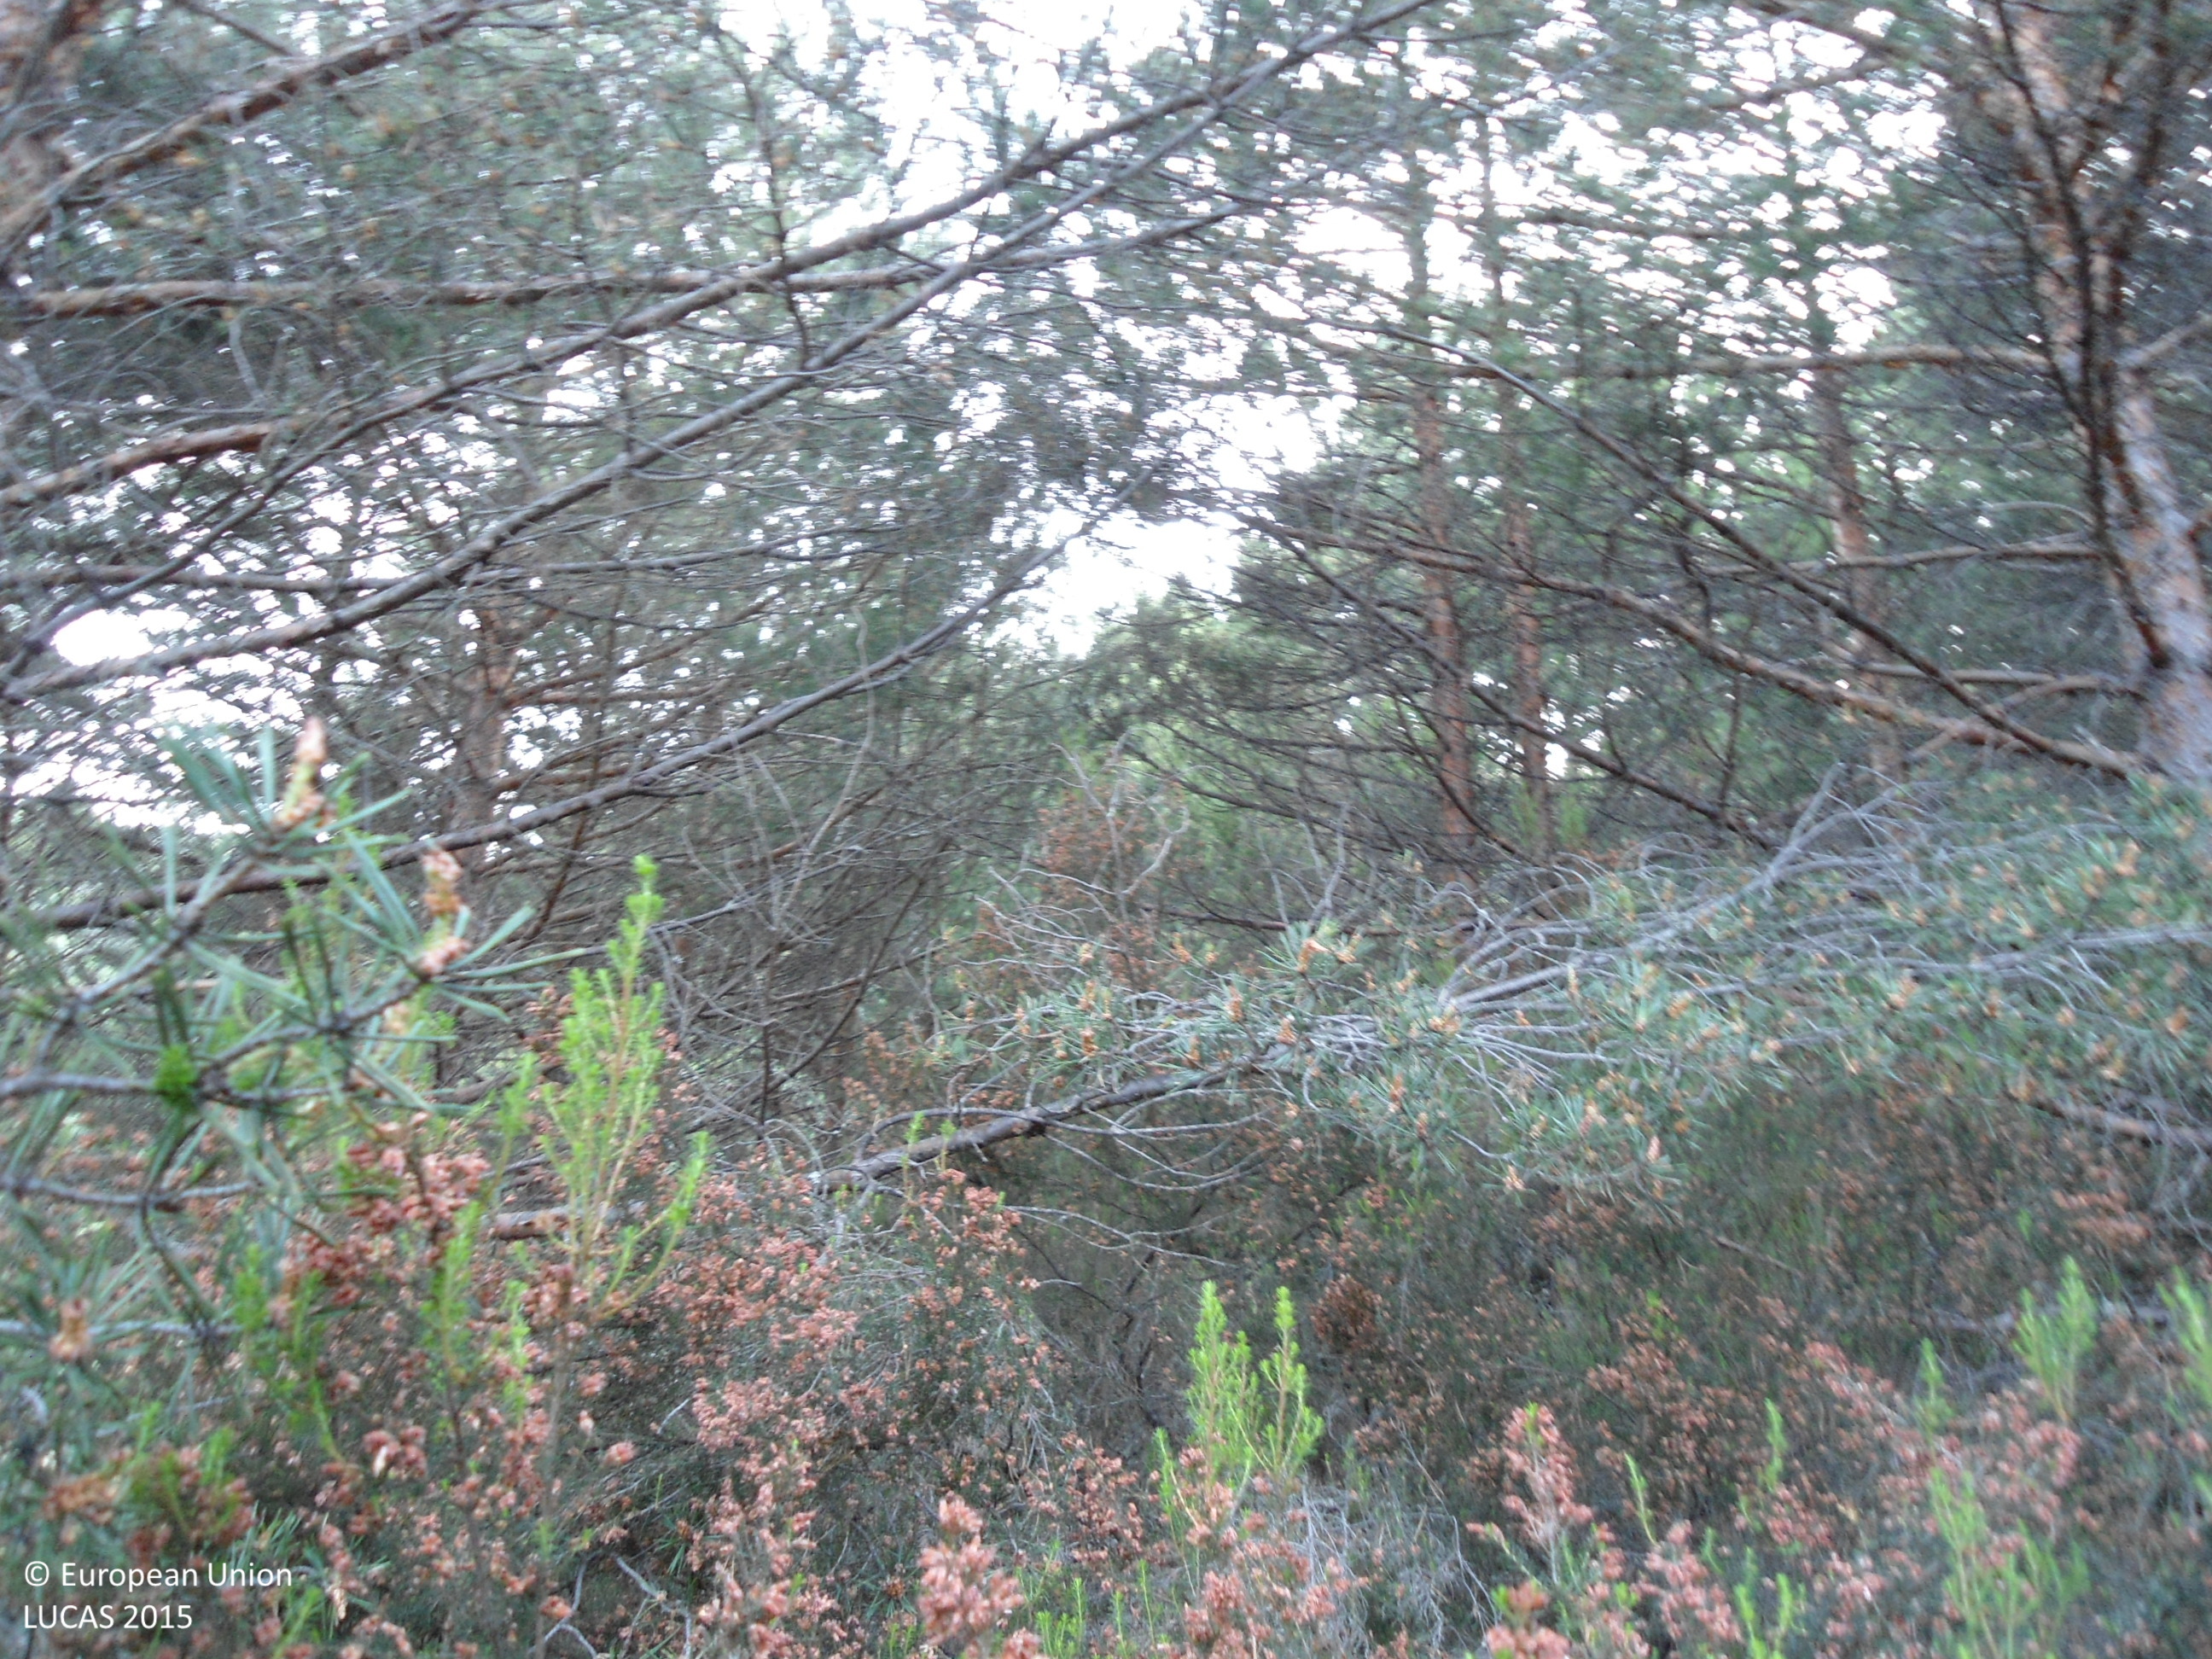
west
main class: Woodland
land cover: Pine dominated coniferous woodland
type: coniferous forest of the mediterranean region
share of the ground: 50 - 75 %
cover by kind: coniferous forest trees 60 %, consolidated bare surface 40 %
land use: Forestry
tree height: > 5 m
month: June
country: ES
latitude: 42.1057
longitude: -6.5713
